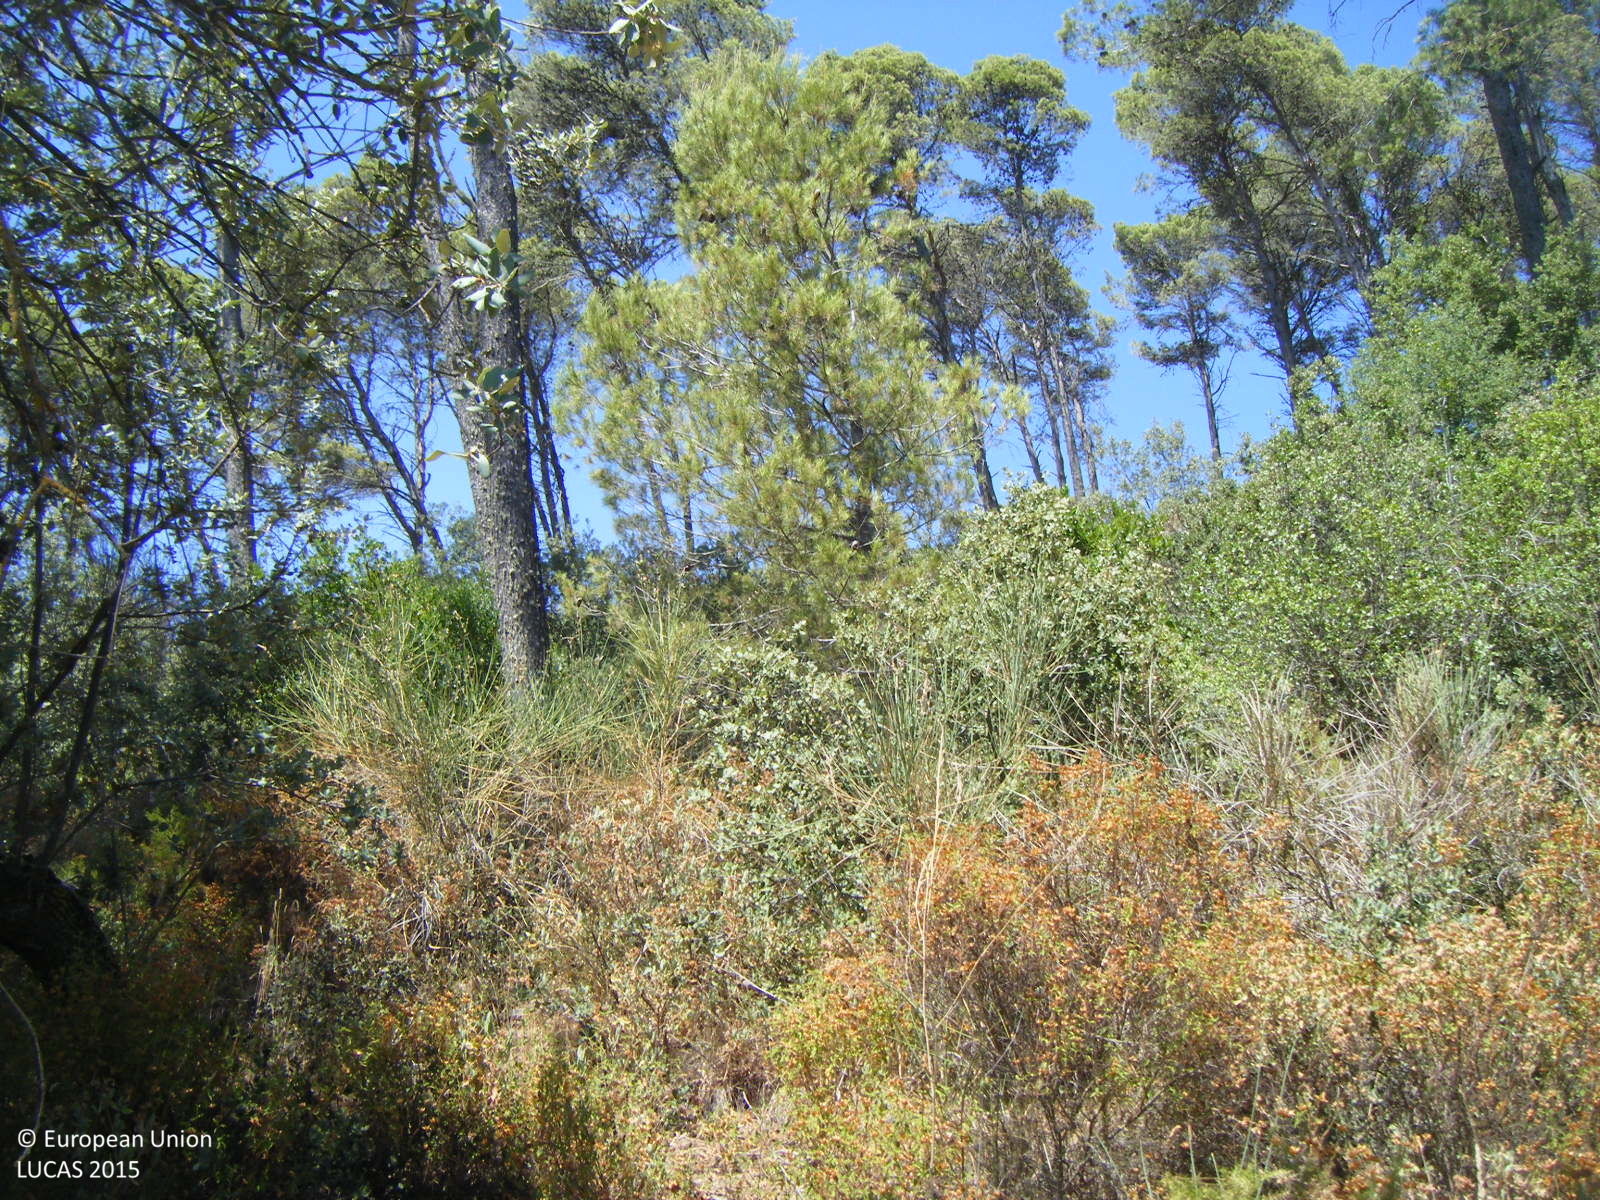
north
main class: Woodland
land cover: Pine dominated coniferous woodland
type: coniferous forest of the mediterranean region
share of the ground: 10 - 25 %
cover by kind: shrubs 80 %, coniferous forest trees 20 %
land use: Forestry
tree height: > 5 m
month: July
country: ES
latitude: 36.8150
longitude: -4.3733
